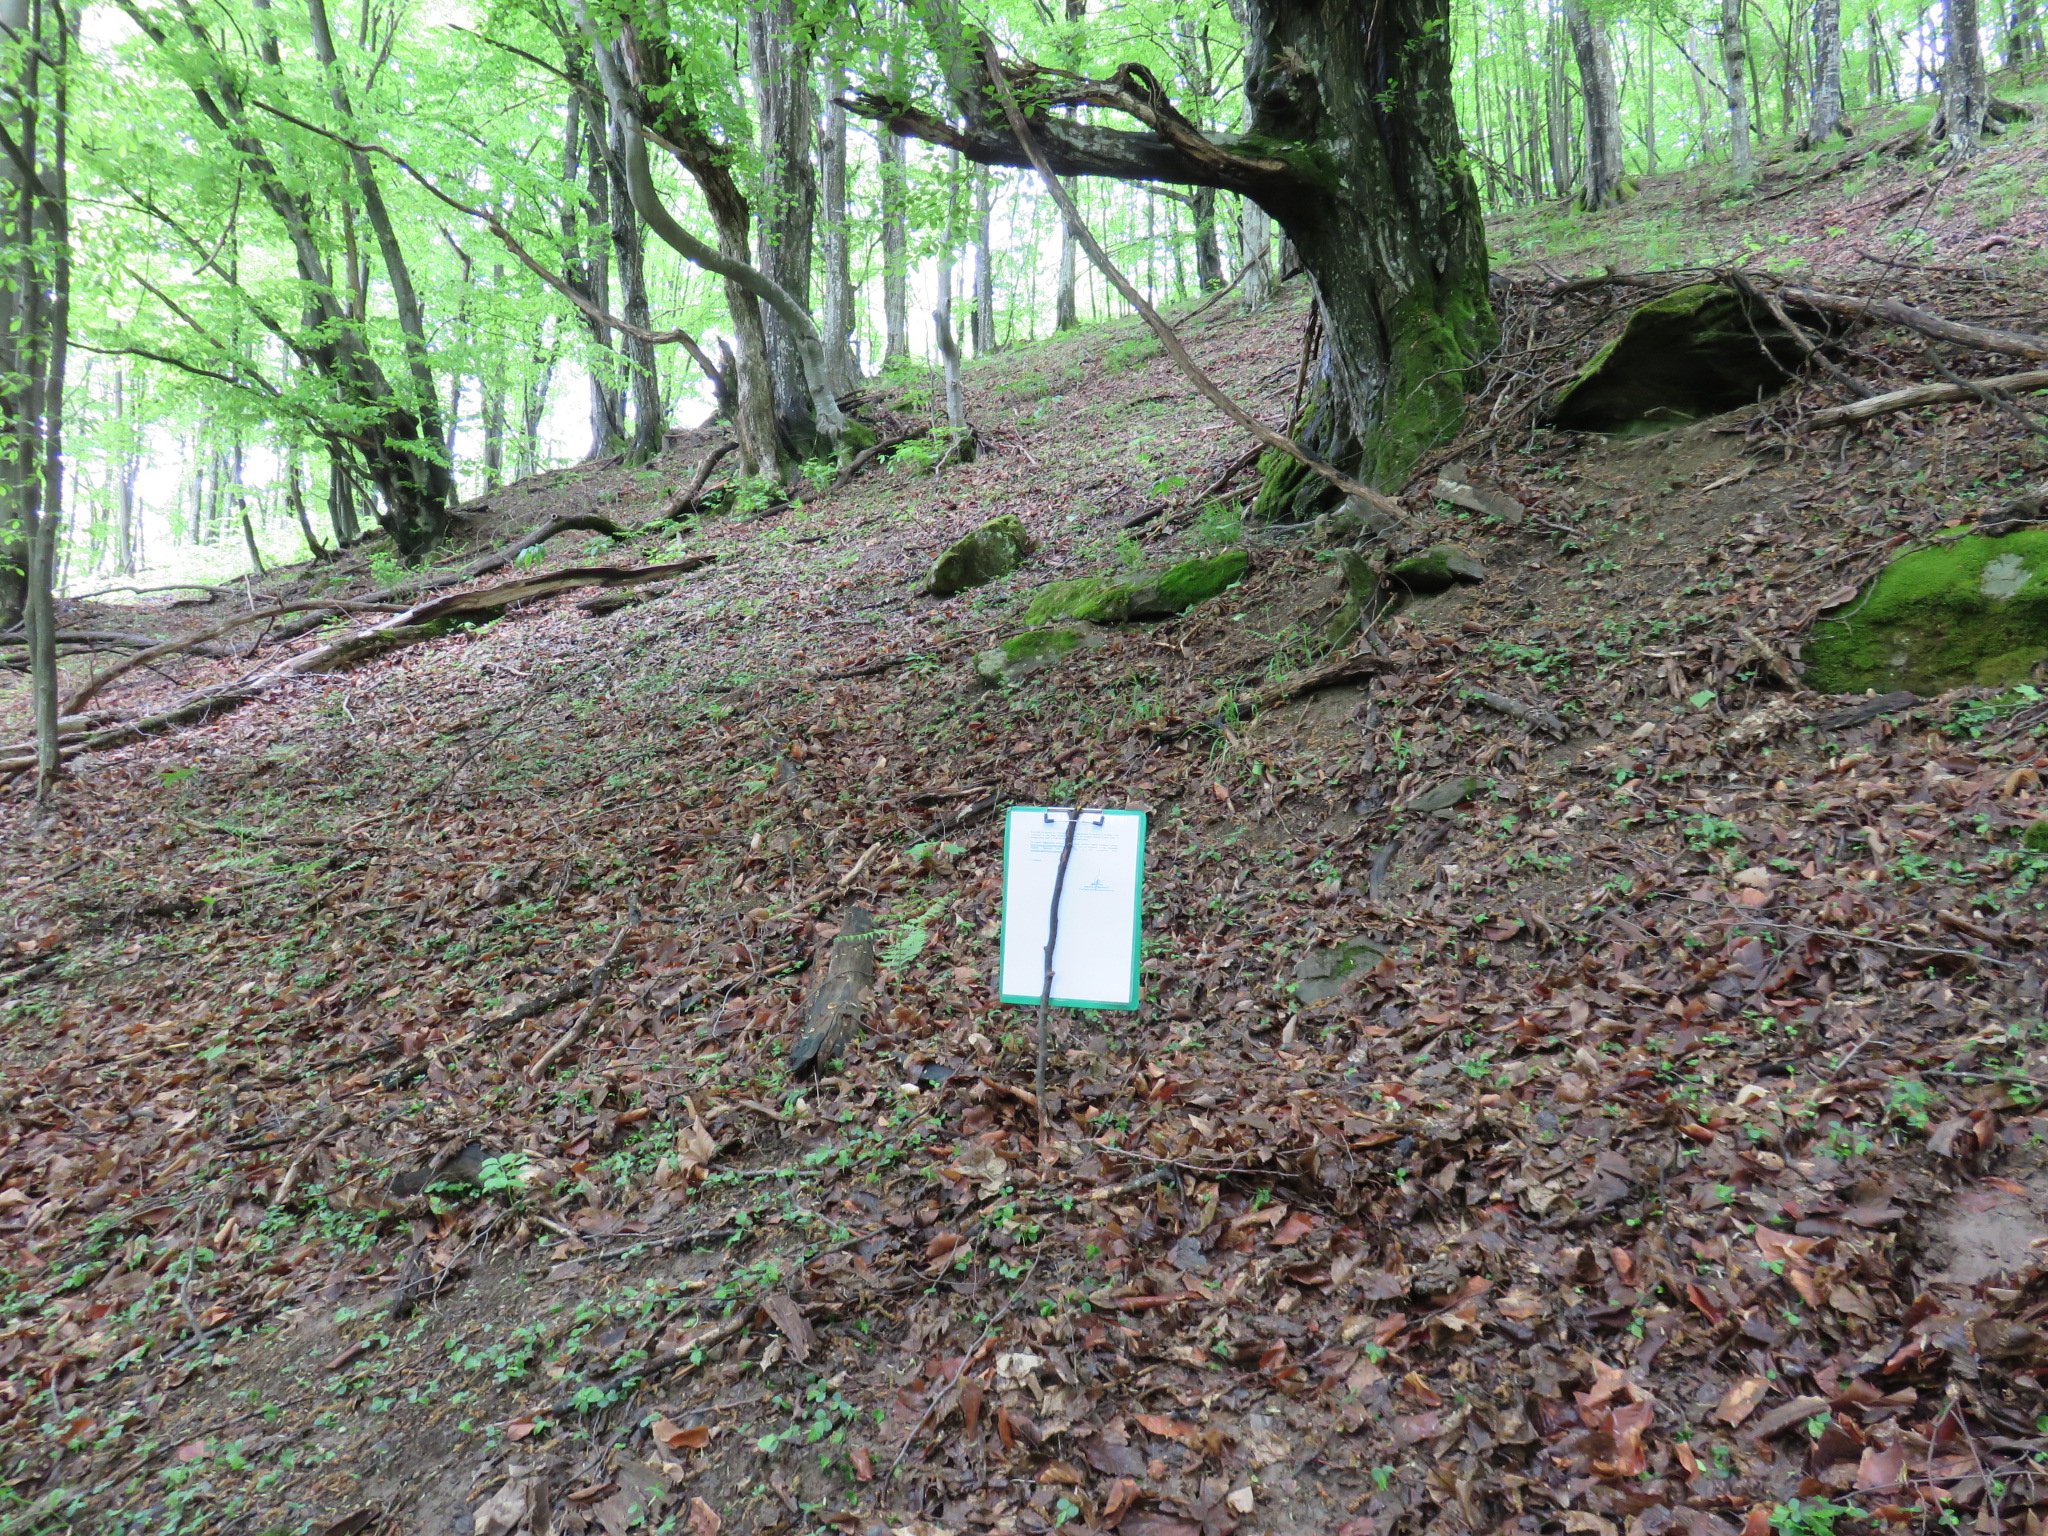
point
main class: Woodland
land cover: Broadleaved woodland
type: beech forest
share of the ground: > 75 %
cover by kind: broadleaved forest trees 80 %, unconsolidated bare surface 20 %
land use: Forestry
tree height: > 5 m
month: May
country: BG
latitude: 42.8068
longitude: 24.7951
